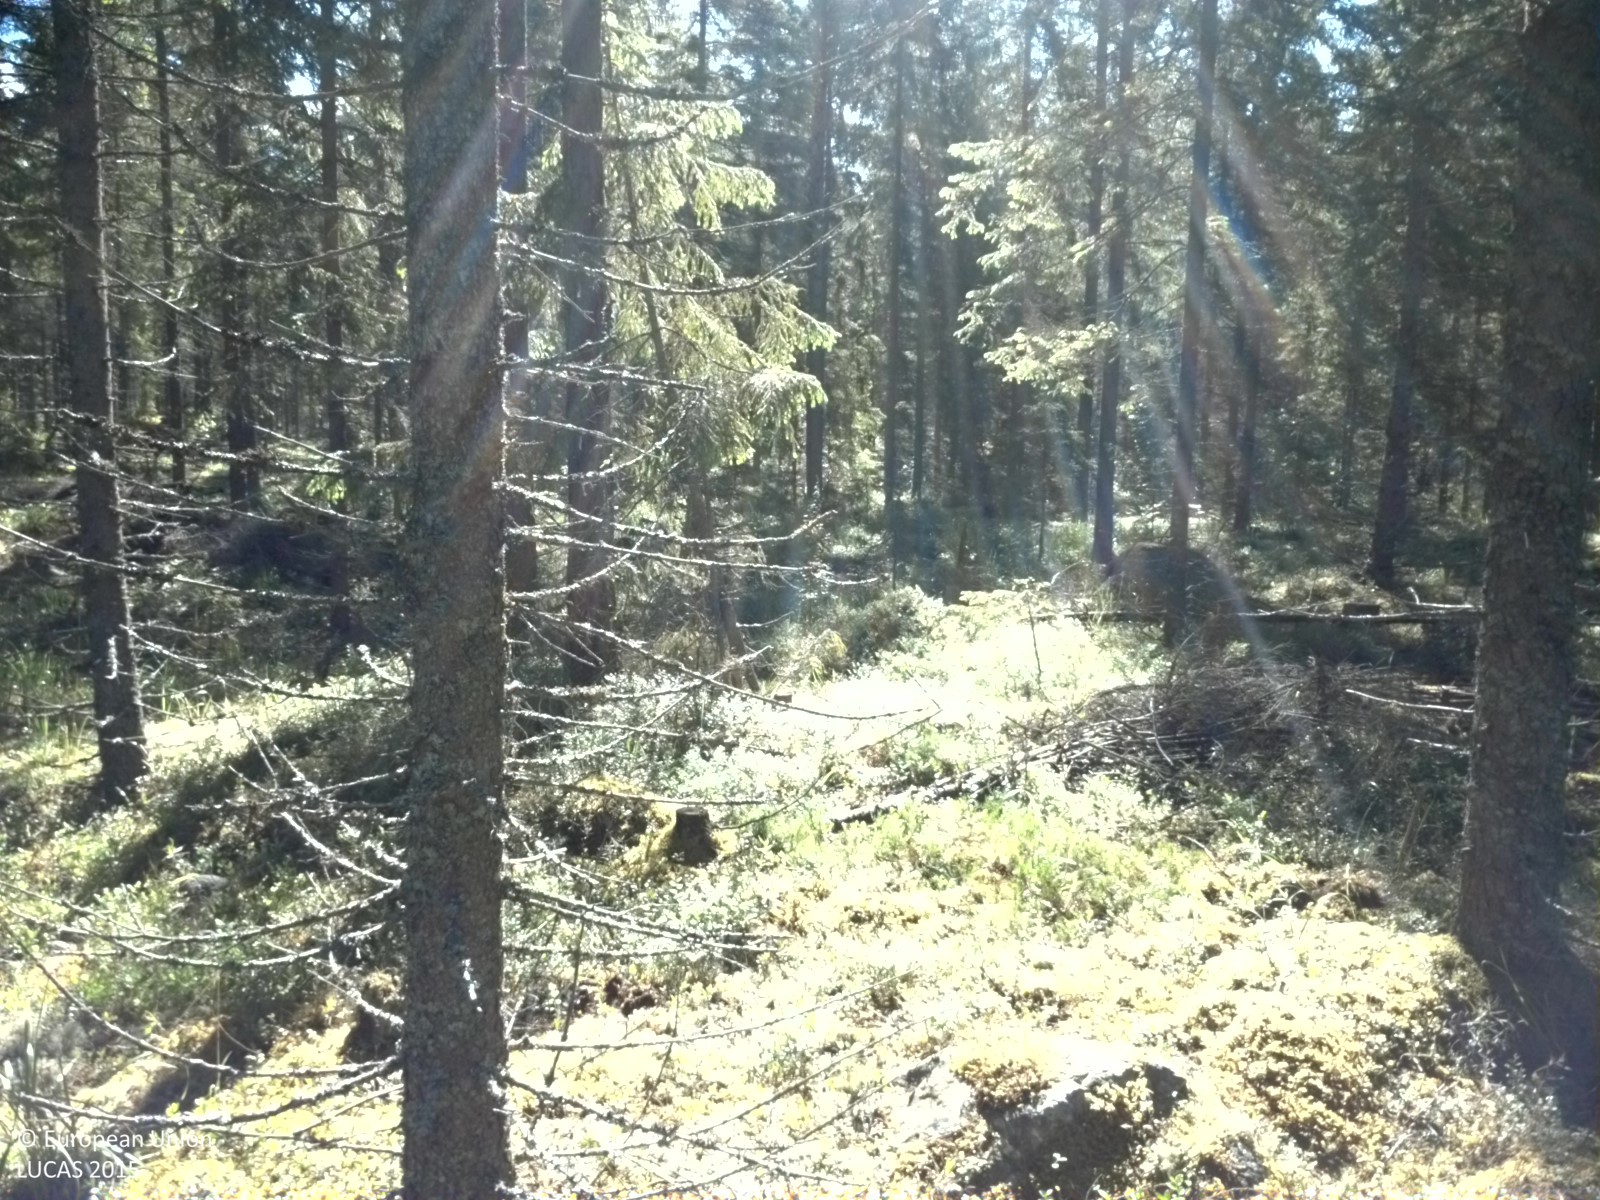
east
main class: Woodland
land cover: Other coniferous woodland
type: boreal forest
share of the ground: 50 - 75 %
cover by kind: coniferous forest trees 60 %, shrubs 15 %, herbaceous plants 10 %, lichens and mosses 10 %, consolidated bare surface 5 %
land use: Forestry
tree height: > 5 m
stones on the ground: 25 - 50 %
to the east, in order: Other coniferous woodland; Pine dominated coniferous woodland; Spruce dominated coniferous woodland
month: June
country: SE
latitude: 60.1341
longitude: 17.6806
